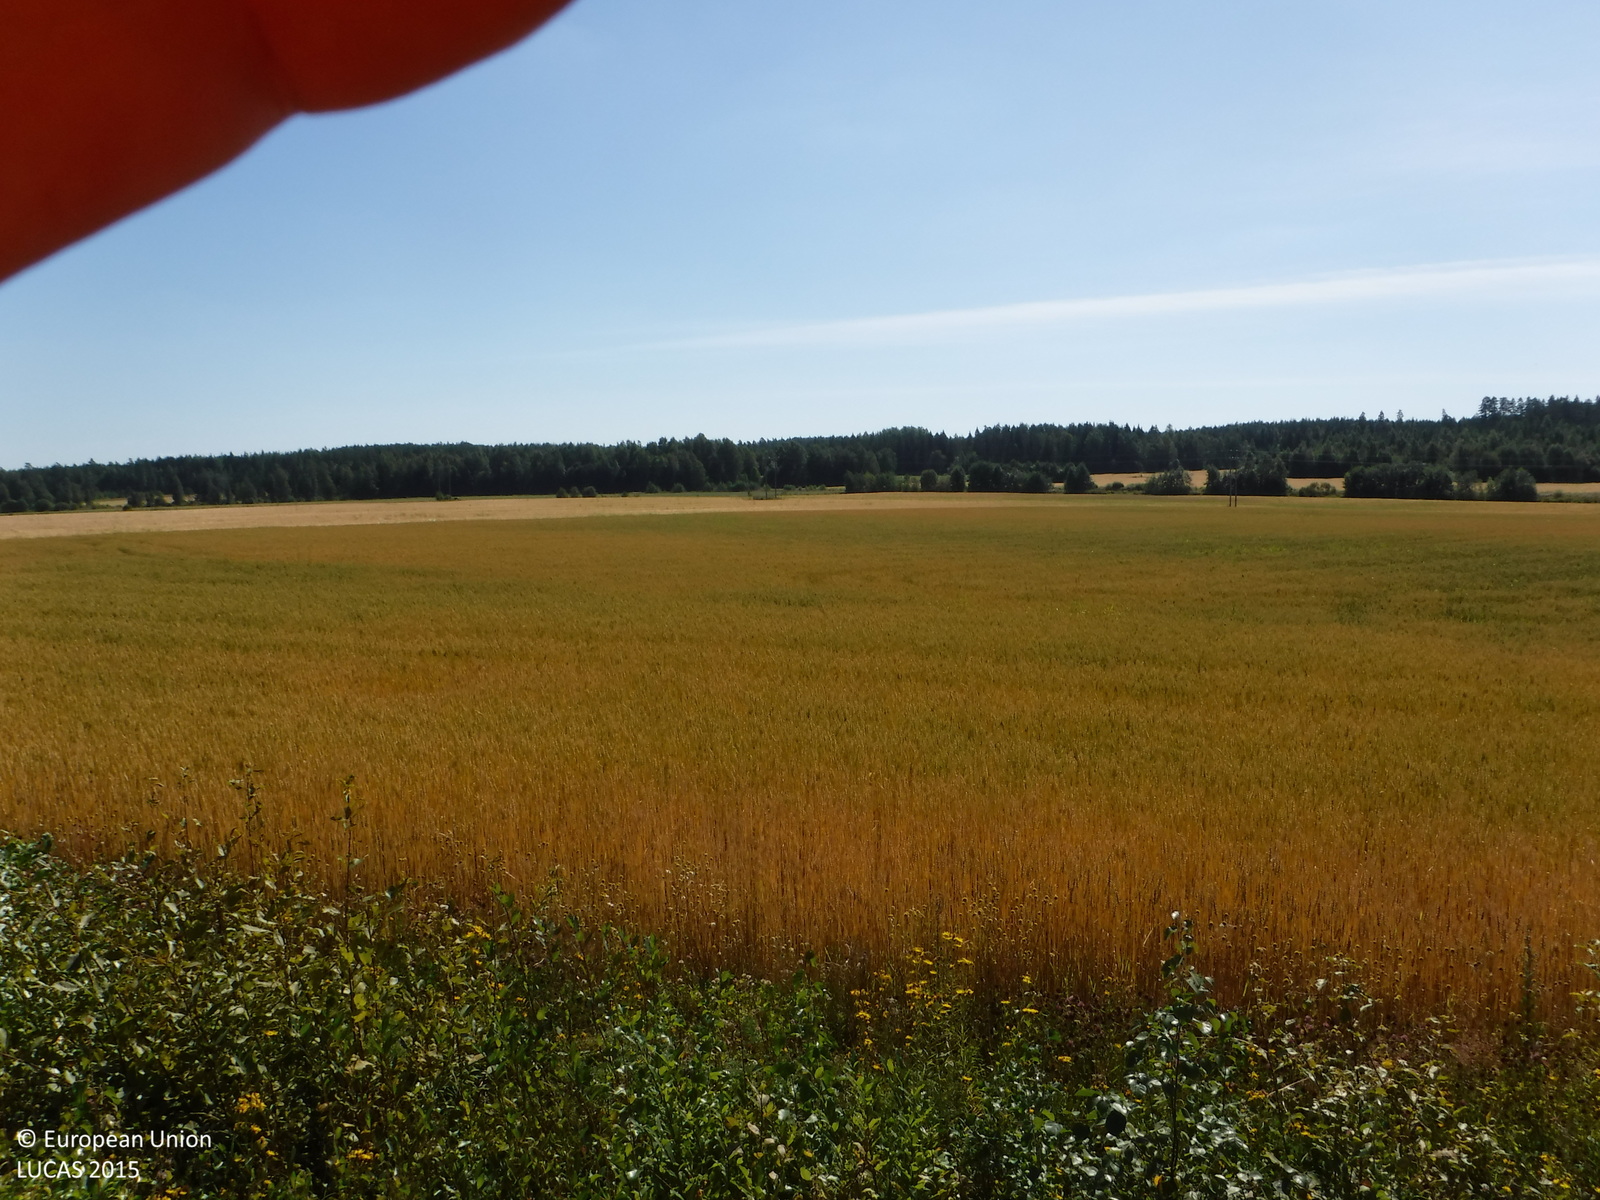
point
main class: Cropland
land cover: Common wheat
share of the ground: > 75 %
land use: Agriculture (excluding fallow land and kitchen gardens)
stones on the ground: < 10 %
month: August
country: FI
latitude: 61.1000
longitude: 21.8734
